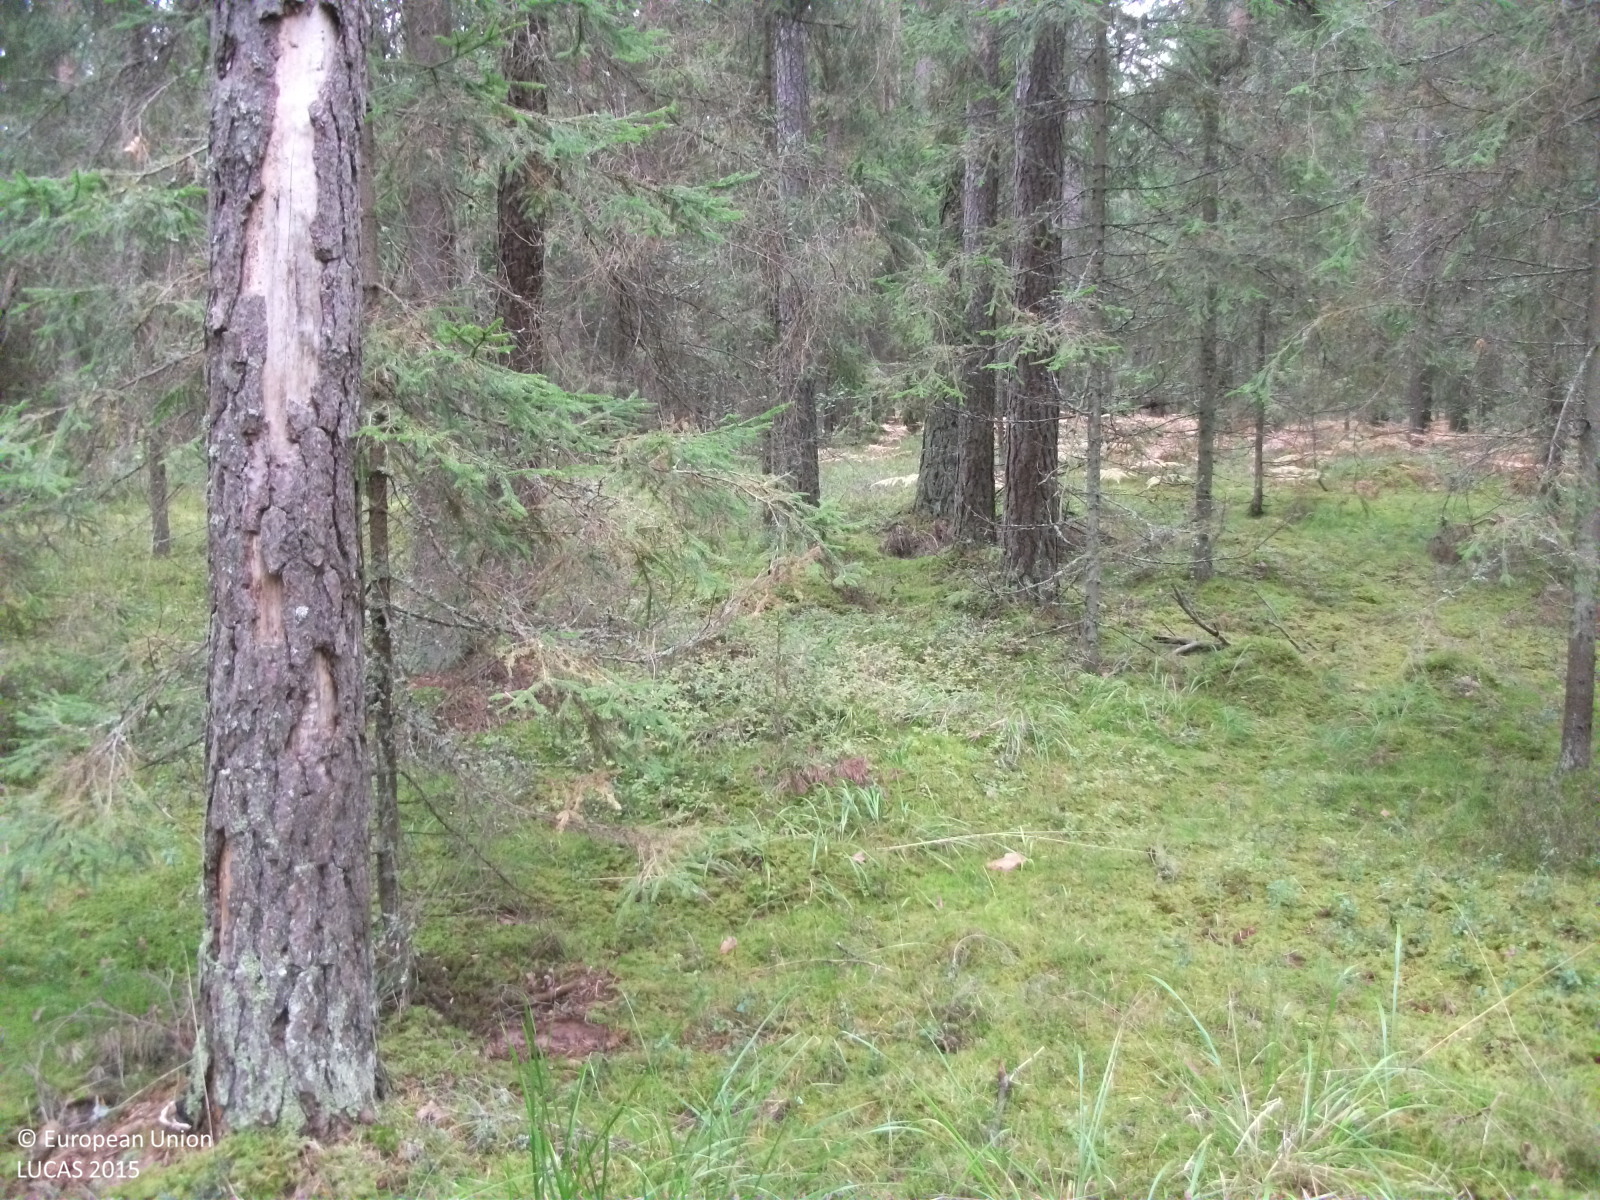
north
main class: Woodland
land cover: Other coniferous woodland
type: hemiboreal forest and nemoral coniferous forest and mixed broadleaved-coniferous forest
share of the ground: > 75 %
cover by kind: coniferous forest trees 80 %, lichens and mosses 15 %, herbaceous plants 5 %
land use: Forestry
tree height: > 5 m
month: September
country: LV
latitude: 57.7263
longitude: 24.4451
